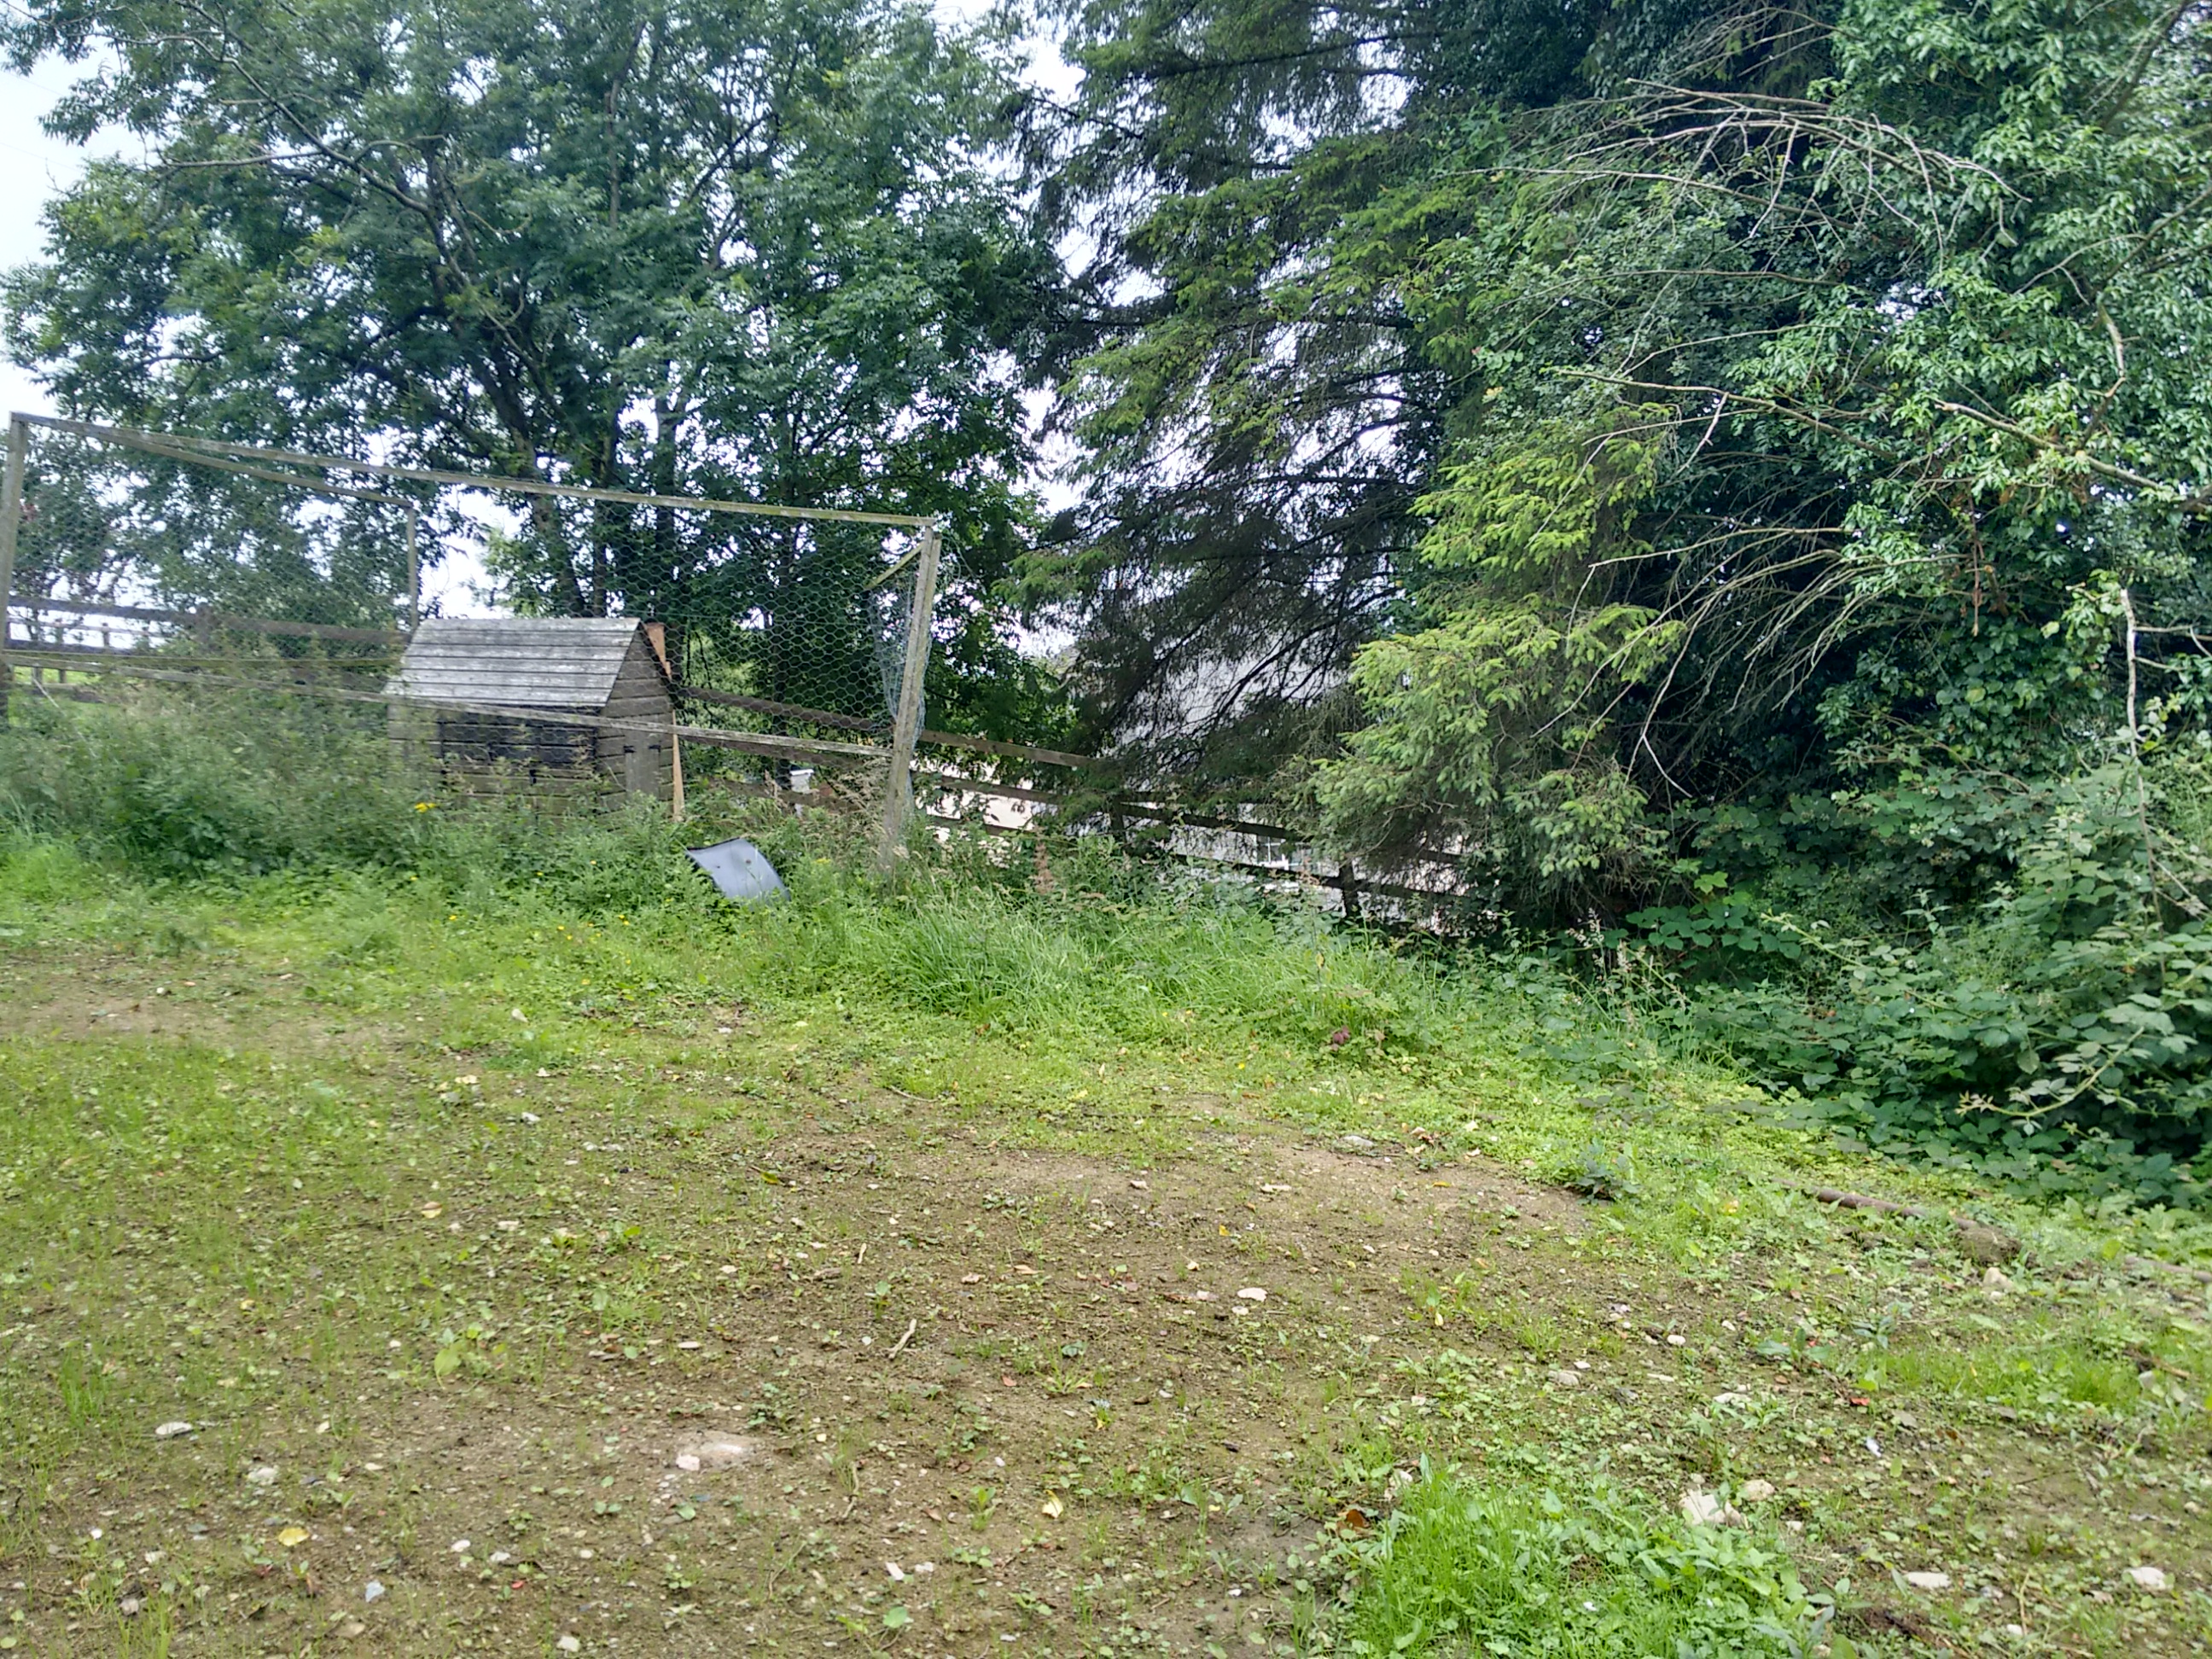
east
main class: Grassland
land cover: Grassland without tree/shrub cover
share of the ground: > 75 %
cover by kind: herbaceous plants 100 %
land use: Agriculture (excluding fallow land and kitchen gardens)
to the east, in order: Grassland without tree/shrub cover; Fences; Grass margins; Rivers and streams; Broadleaved woodland; Abandoned hedges; Artificial constructions in urban areas; Grassland without tree/shrub cover; Fences; Grass margins; Tracks; Grass margins; Fences; Abandoned hedges; Paved roads, cycling and walking lanes; Abandoned hedges
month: August
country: GB
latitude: 54.5982
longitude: -6.8675
